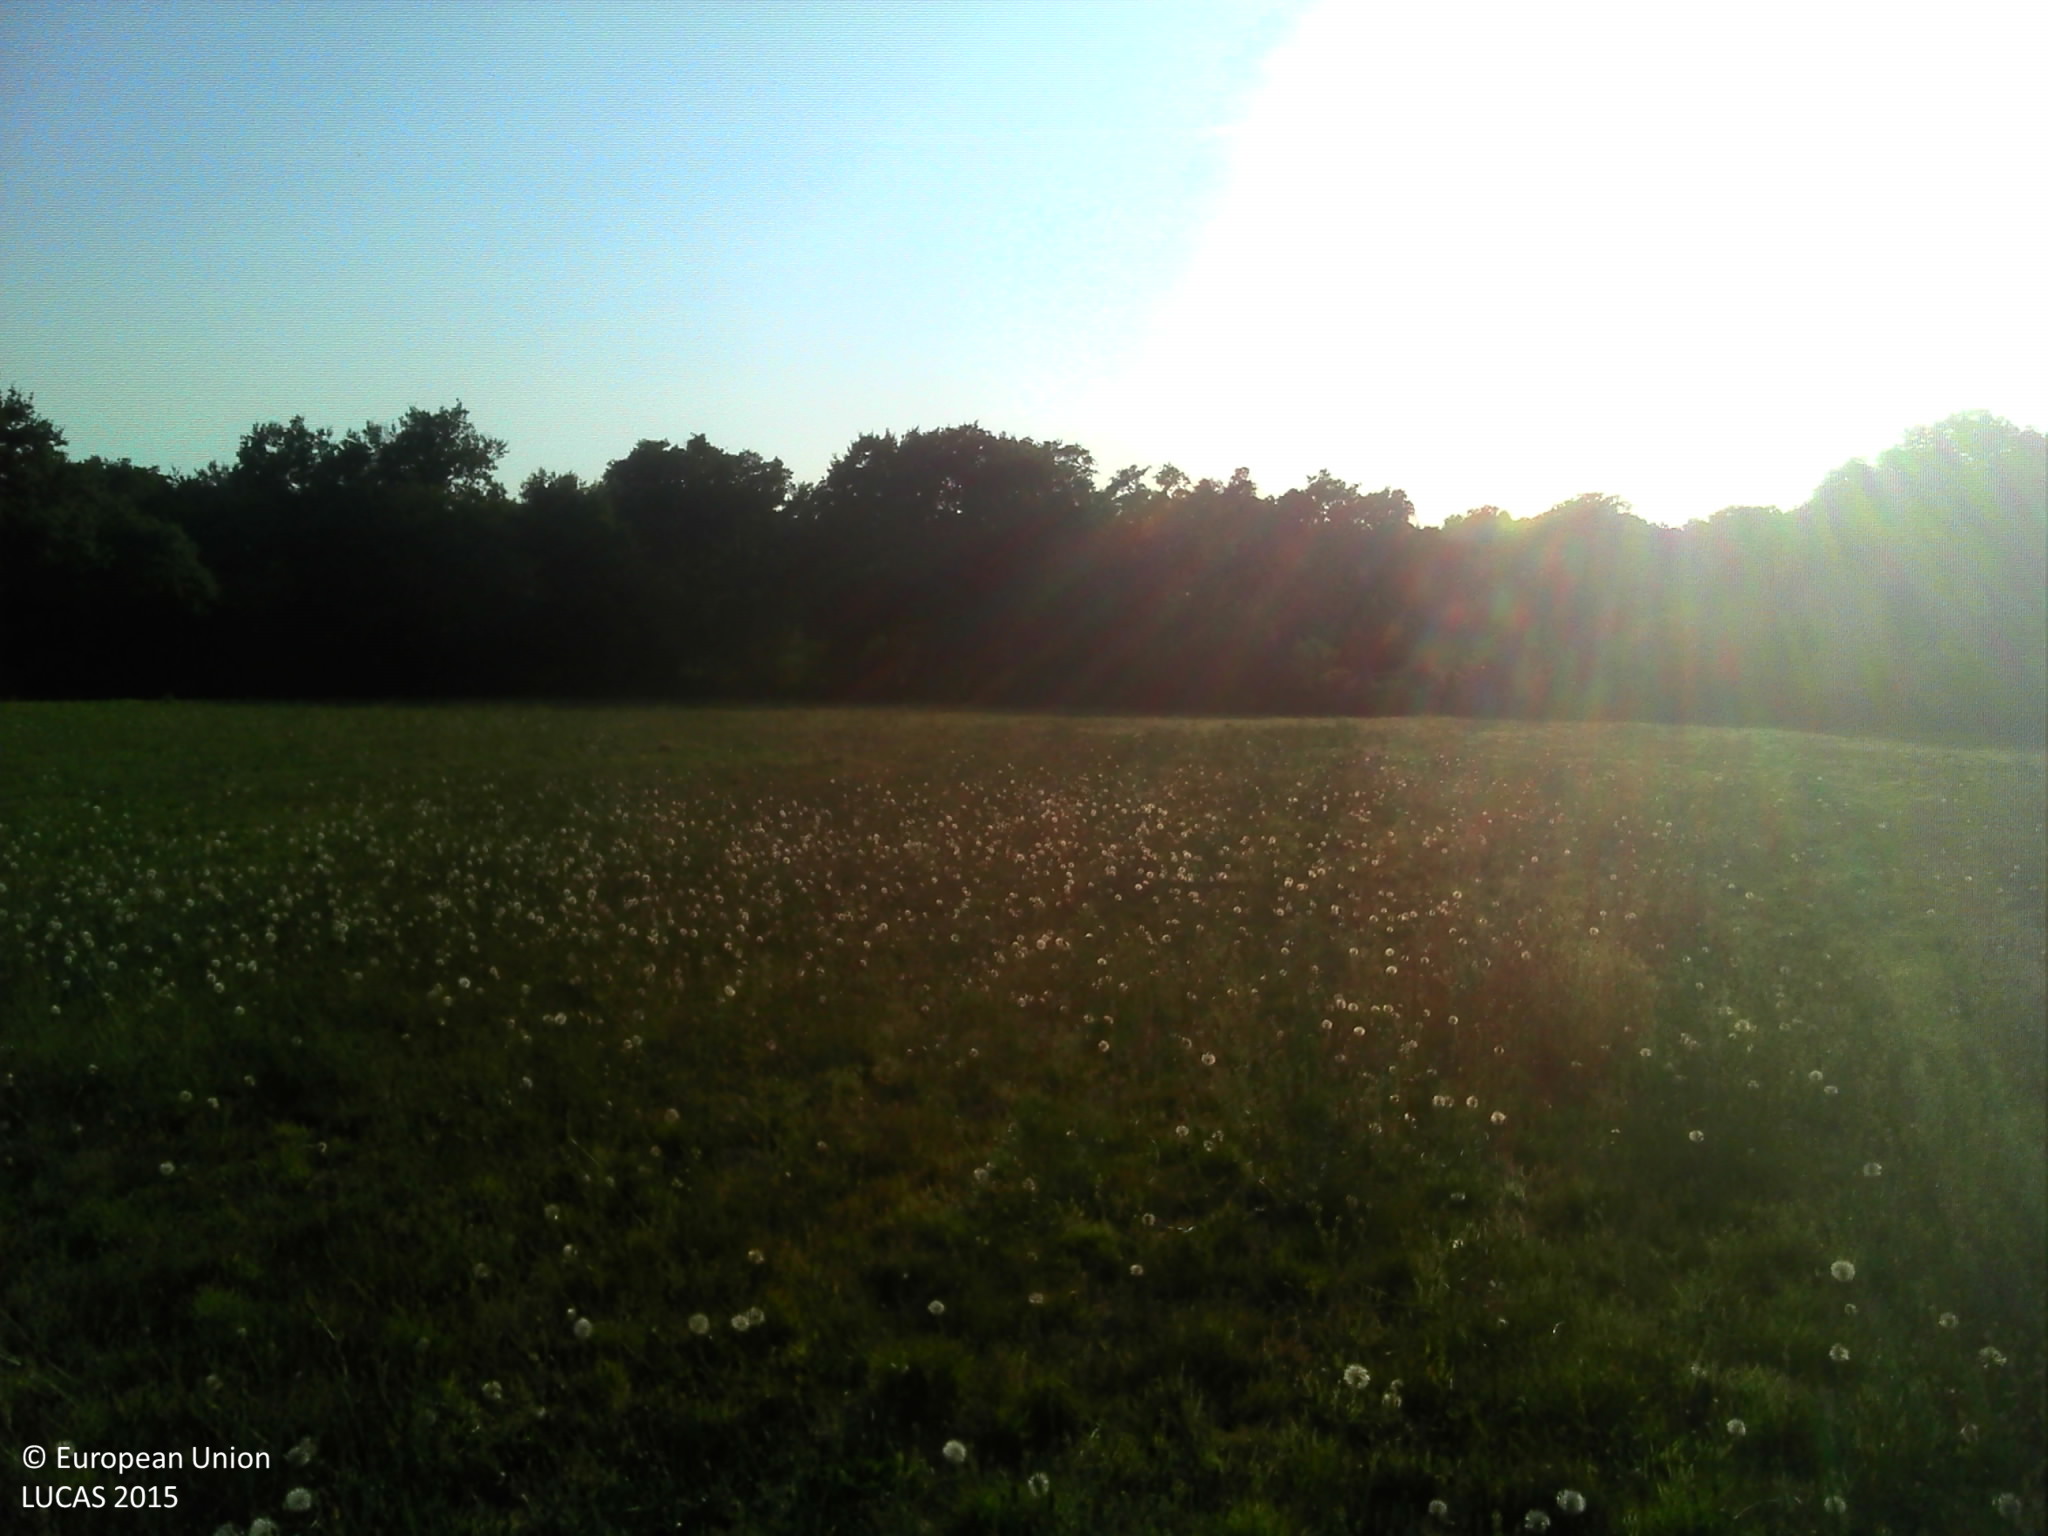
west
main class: Grassland
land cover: Grassland without tree/shrub cover
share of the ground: > 75 %
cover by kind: herbaceous plants 100 %
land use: Agriculture (excluding fallow land and kitchen gardens)
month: July
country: FR
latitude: 46.4917
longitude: -1.6742
